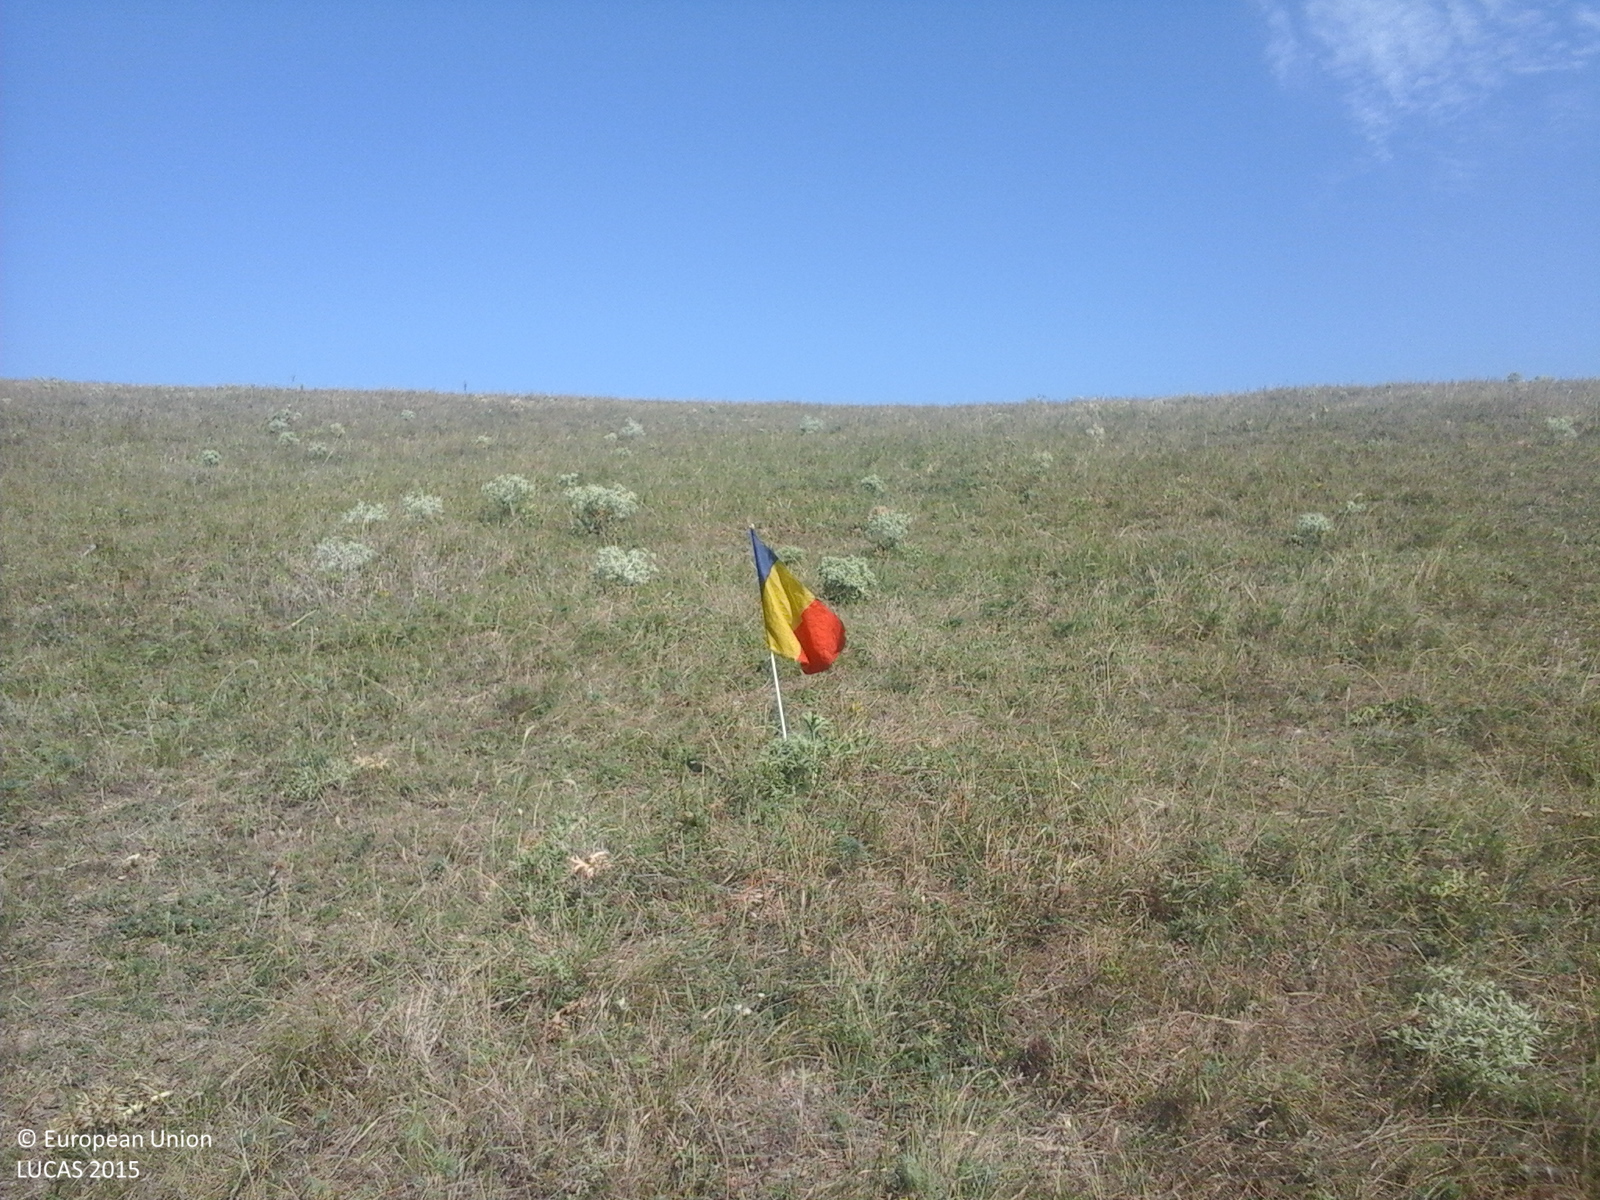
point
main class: Grassland
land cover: Grassland without tree/shrub cover
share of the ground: > 75 %
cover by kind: herbaceous plants 100 %
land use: Agriculture (excluding fallow land and kitchen gardens)
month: August
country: RO
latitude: 46.3519
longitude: 27.5906
